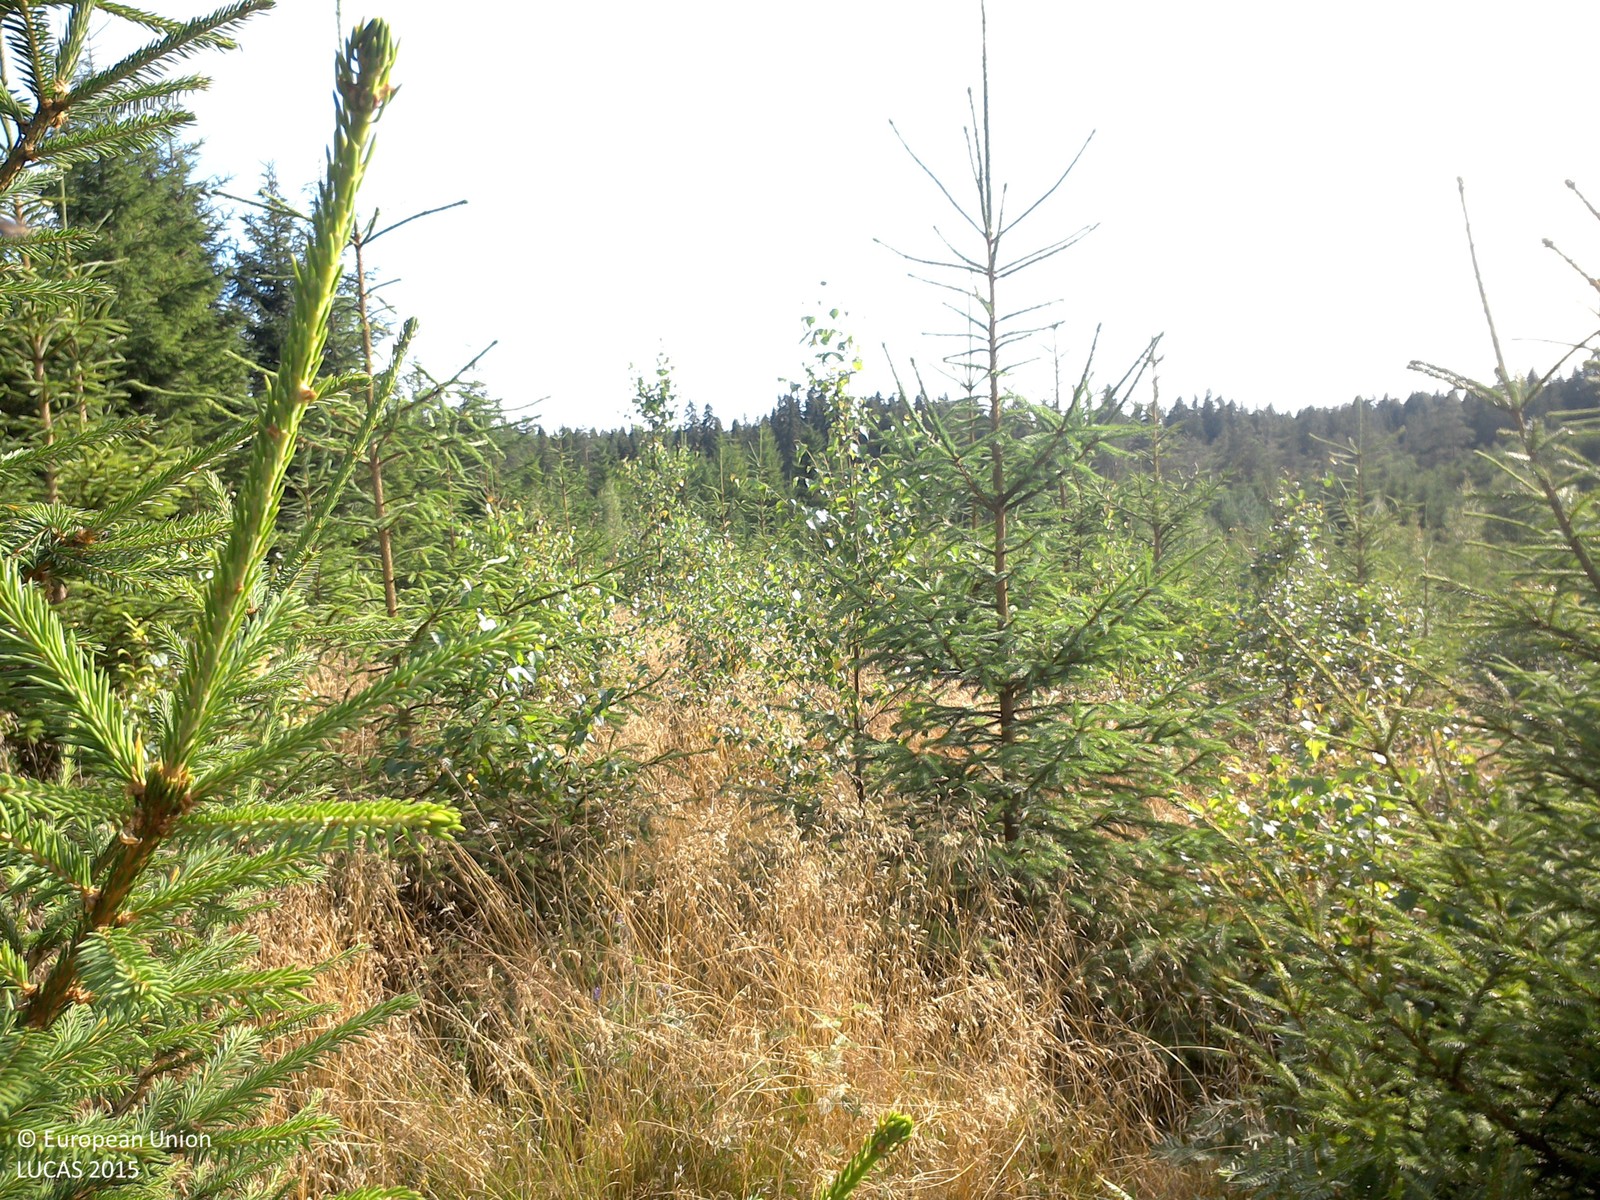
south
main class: Woodland
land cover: Spruce dominated mixed woodland
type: boreal forest
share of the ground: 25 - 50 %
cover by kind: herbaceous plants 70 %, coniferous forest trees 20 %, broadleaved forest trees 10 %
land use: Forestry
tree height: < 5 m
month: August
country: SE
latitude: 57.8664
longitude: 15.2041
